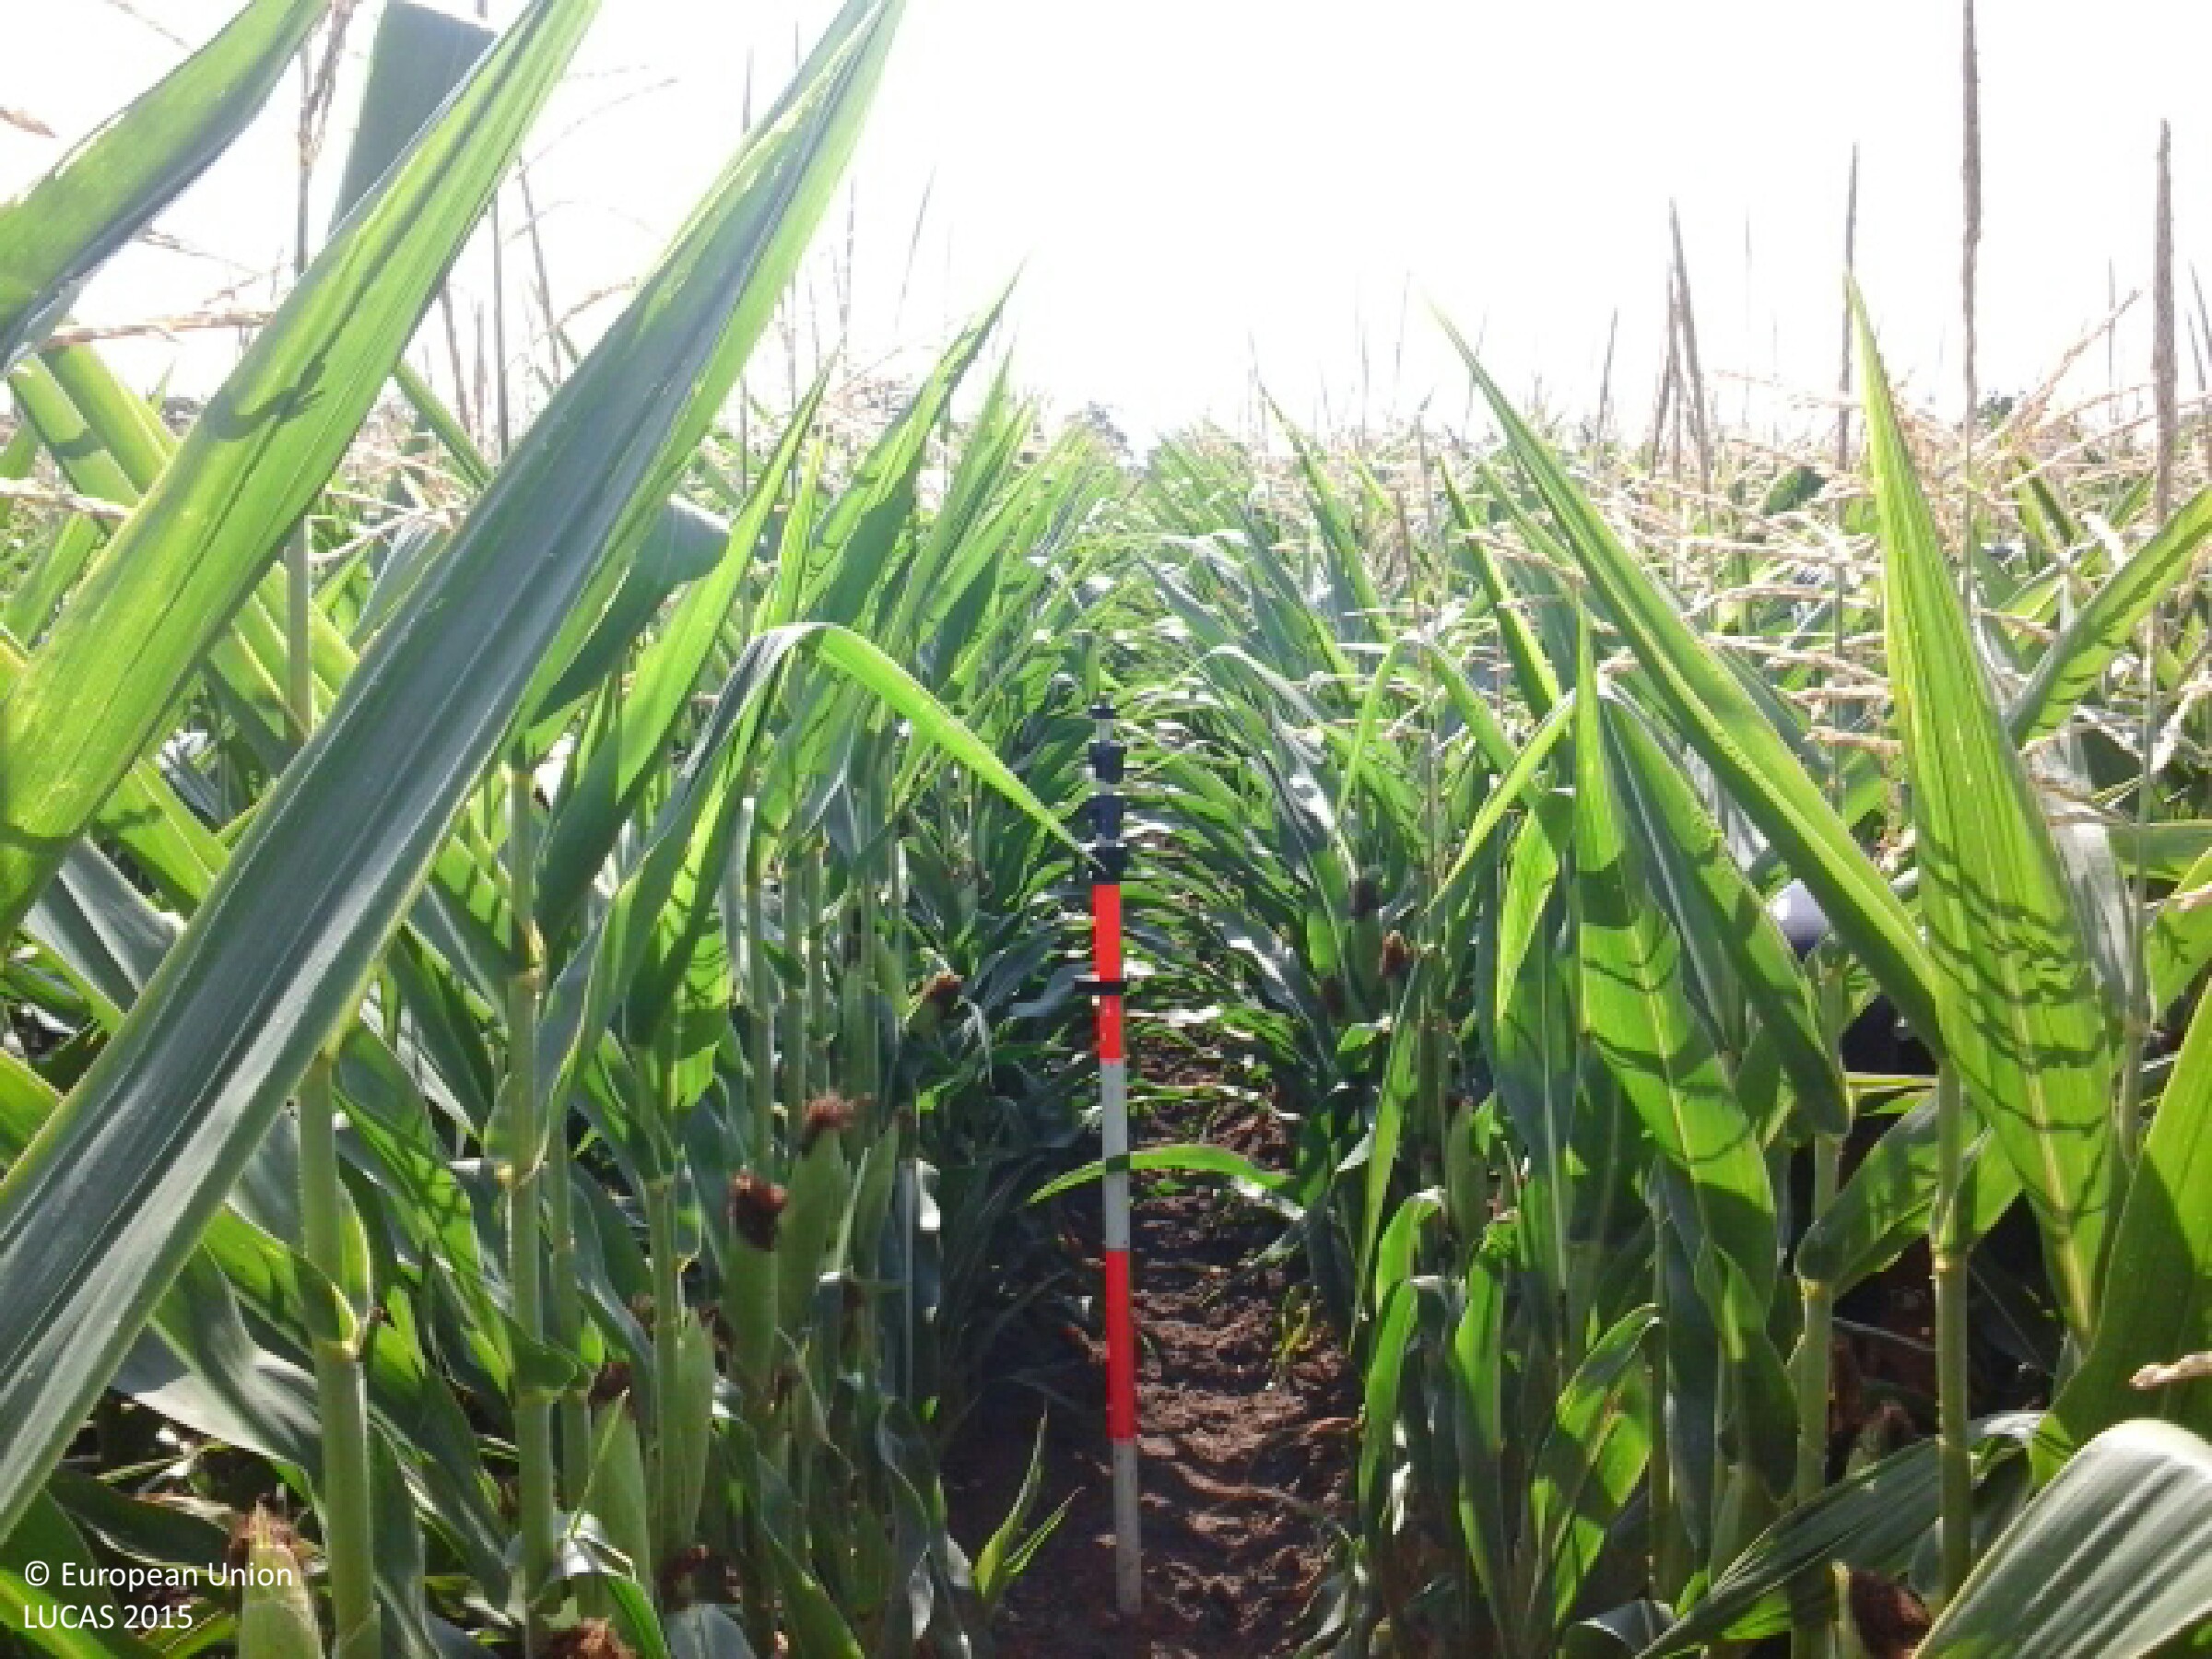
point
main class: Cropland
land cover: Maize
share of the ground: > 75 %
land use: Agriculture (excluding fallow land and kitchen gardens)
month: August
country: HU
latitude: 47.5829
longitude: 18.0822
